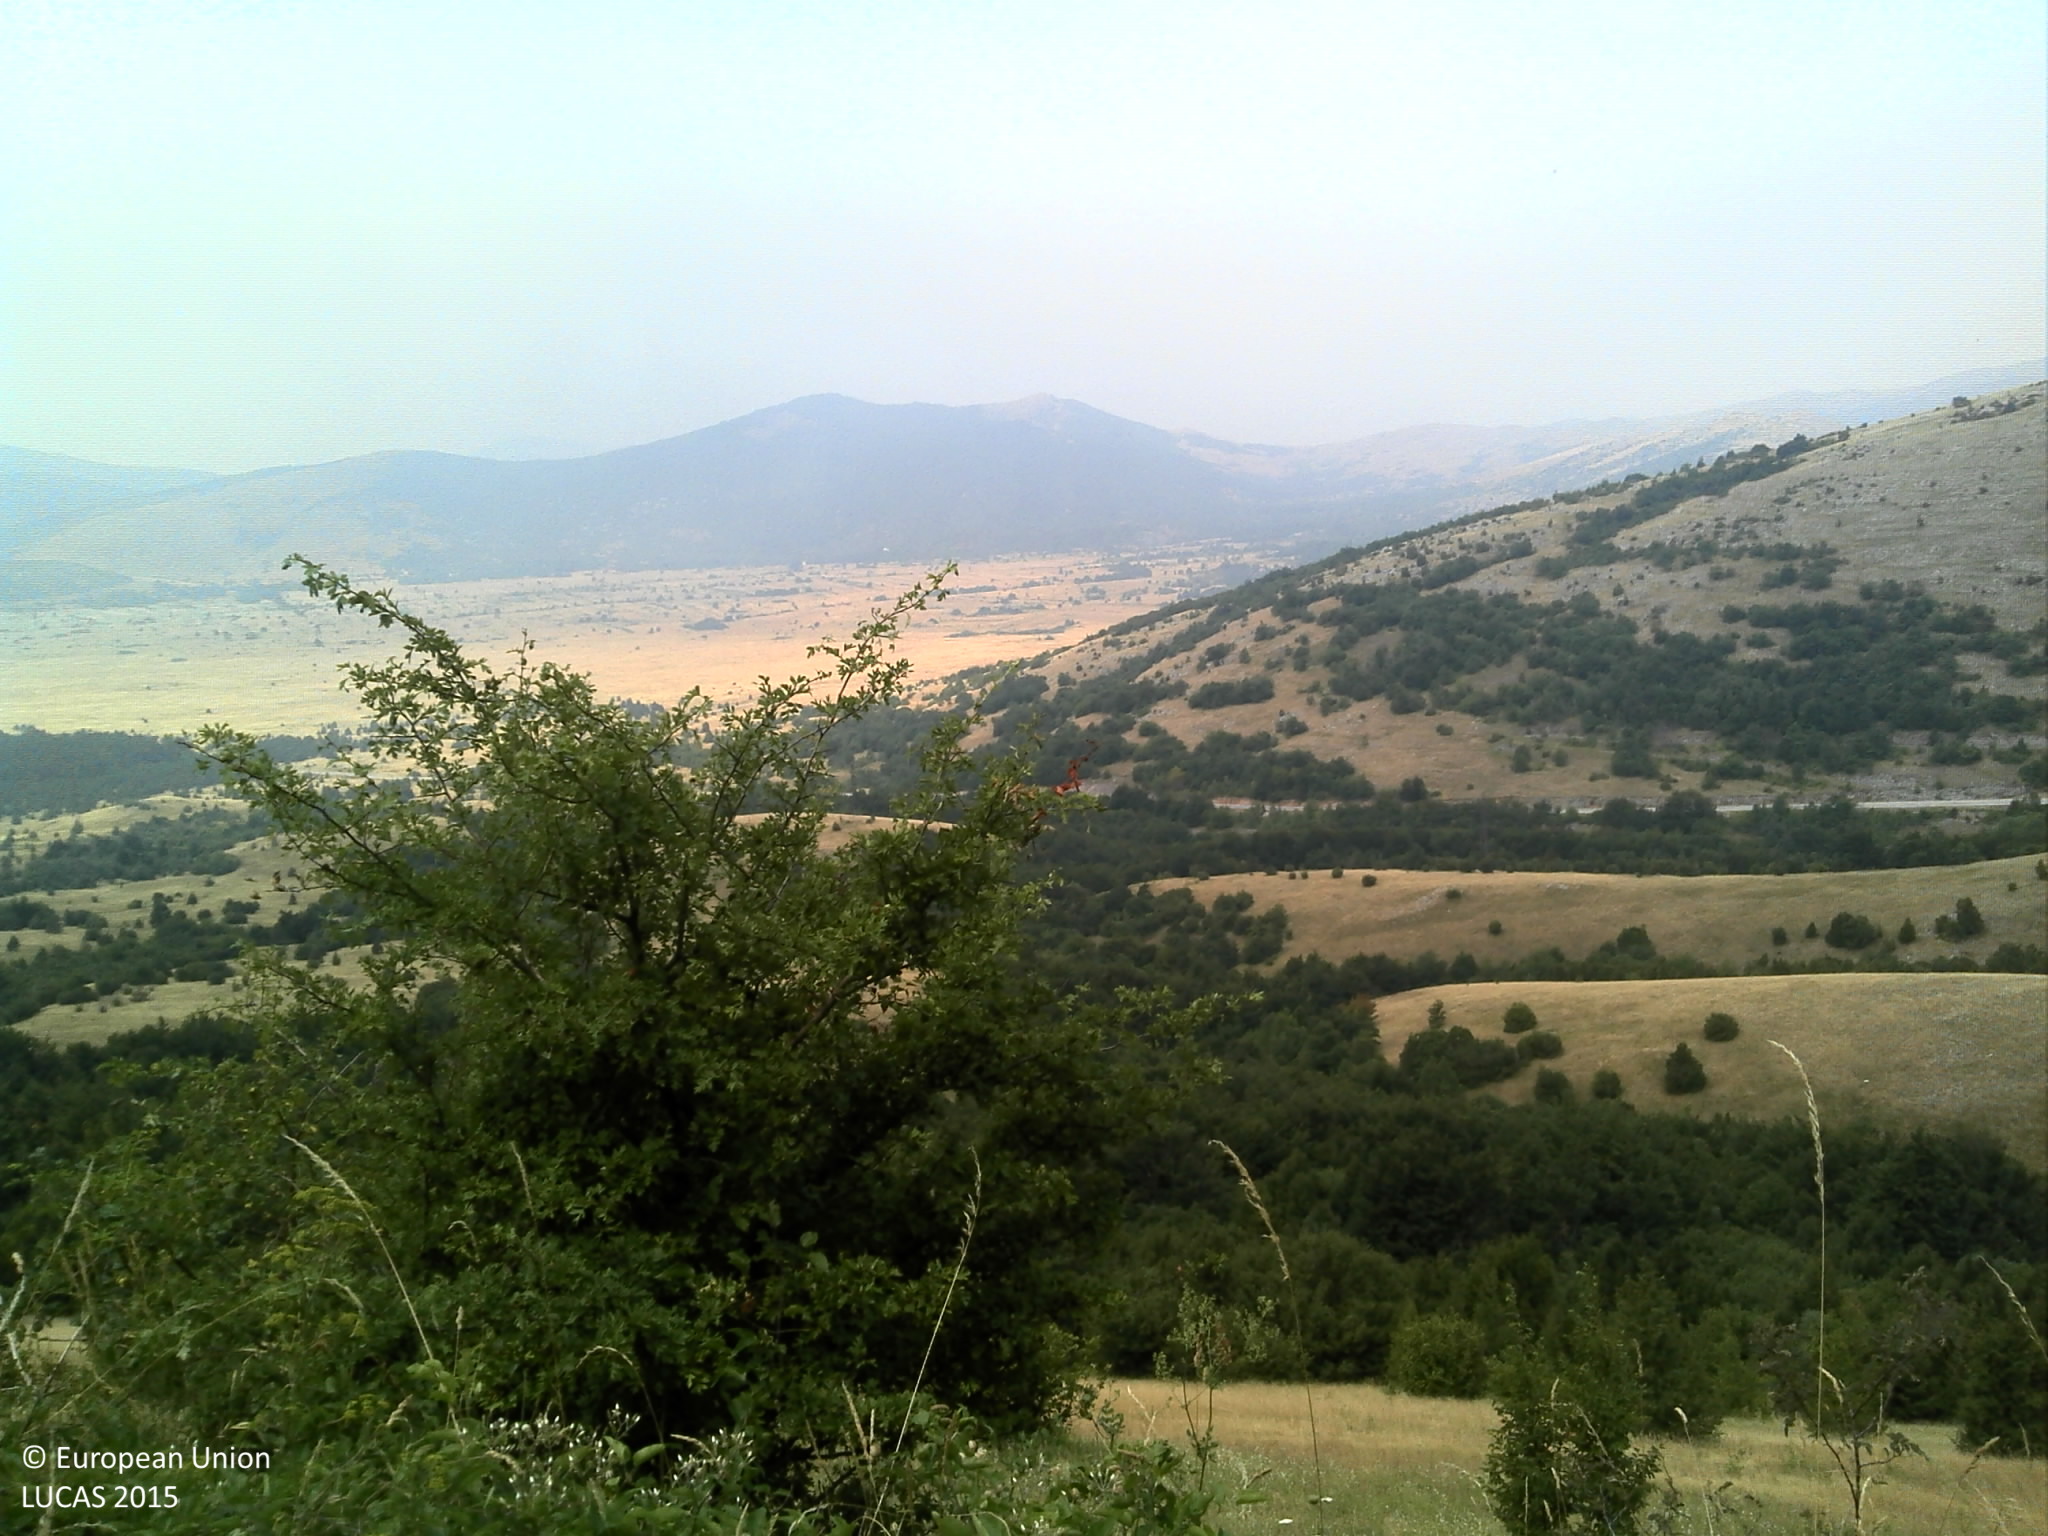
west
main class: Woodland
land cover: Pine dominated coniferous woodland
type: coniferous forest of the mediterranean region
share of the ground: > 75 %
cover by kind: coniferous forest trees 80 %, herbaceous plants 10 %, broadleaved forest trees 5 %, consolidated bare surface 5 %
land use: Semi-natural and natural areas not in use
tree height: > 5 m
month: July
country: HR
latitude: 44.2784
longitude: 16.1202
